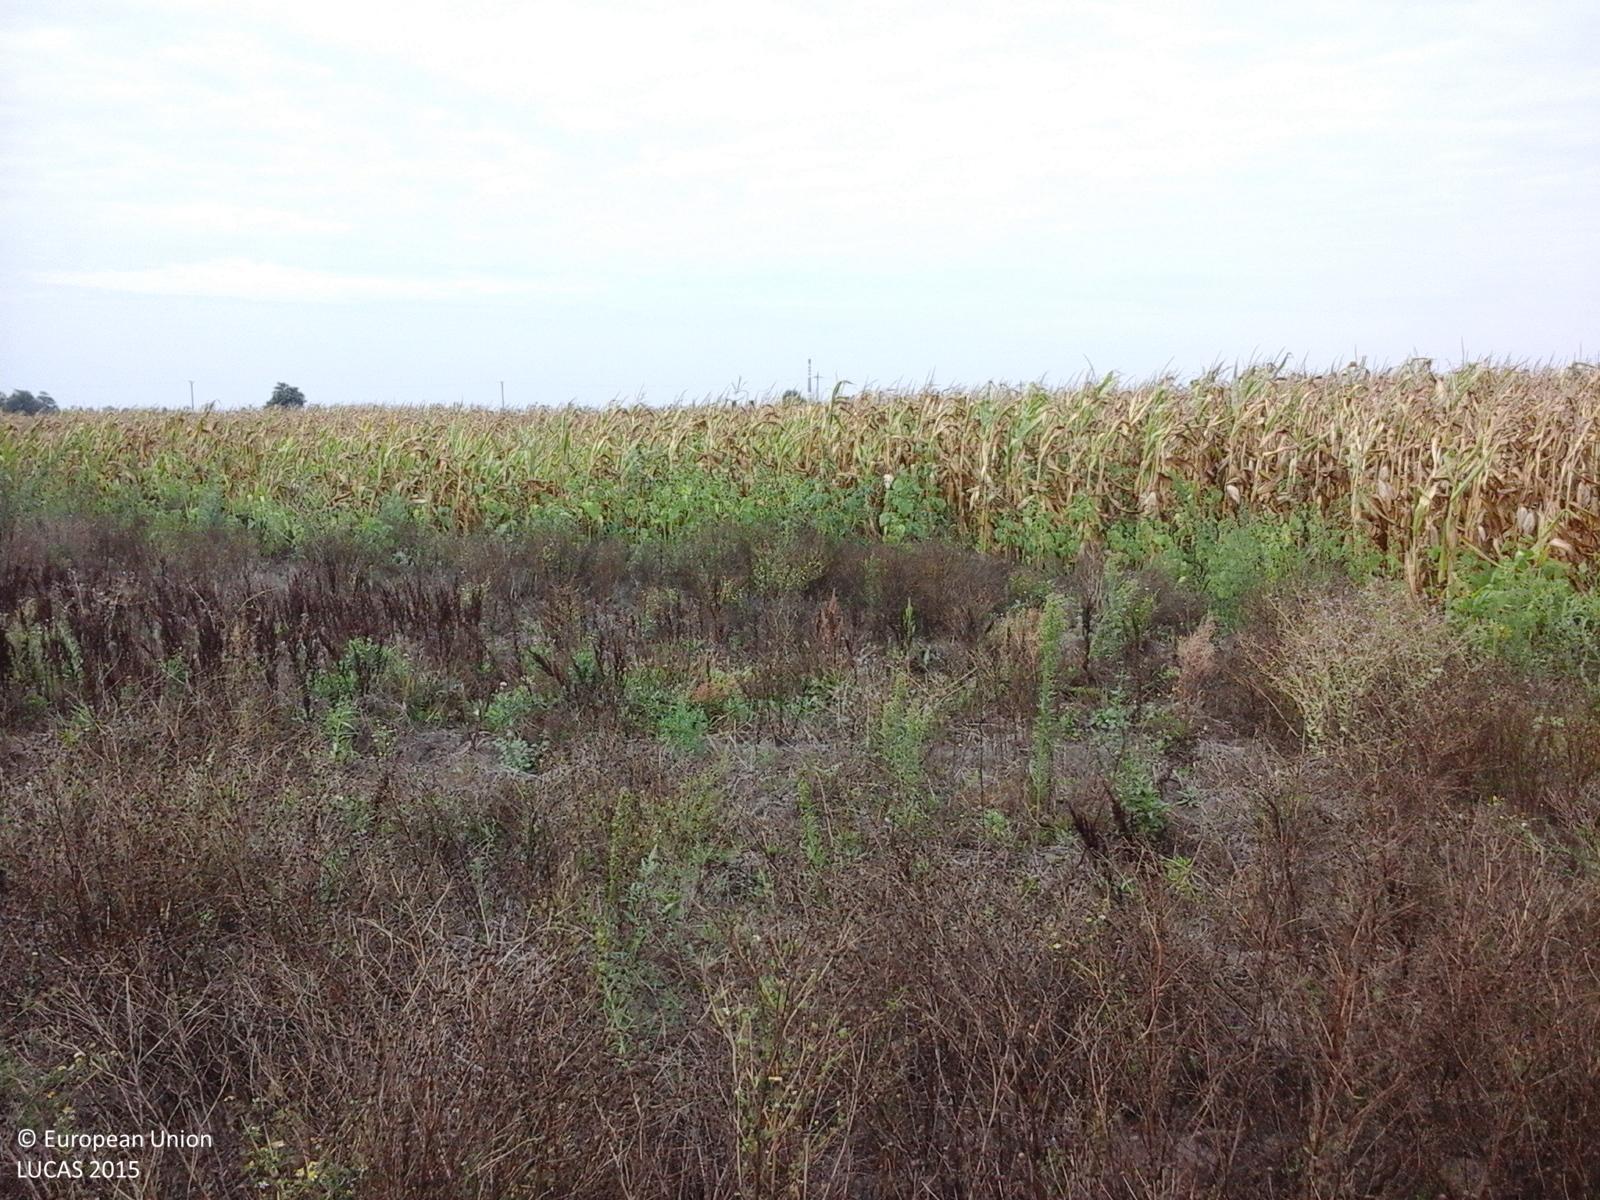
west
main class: Cropland
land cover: Maize
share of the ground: > 75 %
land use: Agriculture (excluding fallow land and kitchen gardens)
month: August
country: RO
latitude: 46.1900
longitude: 20.7428
